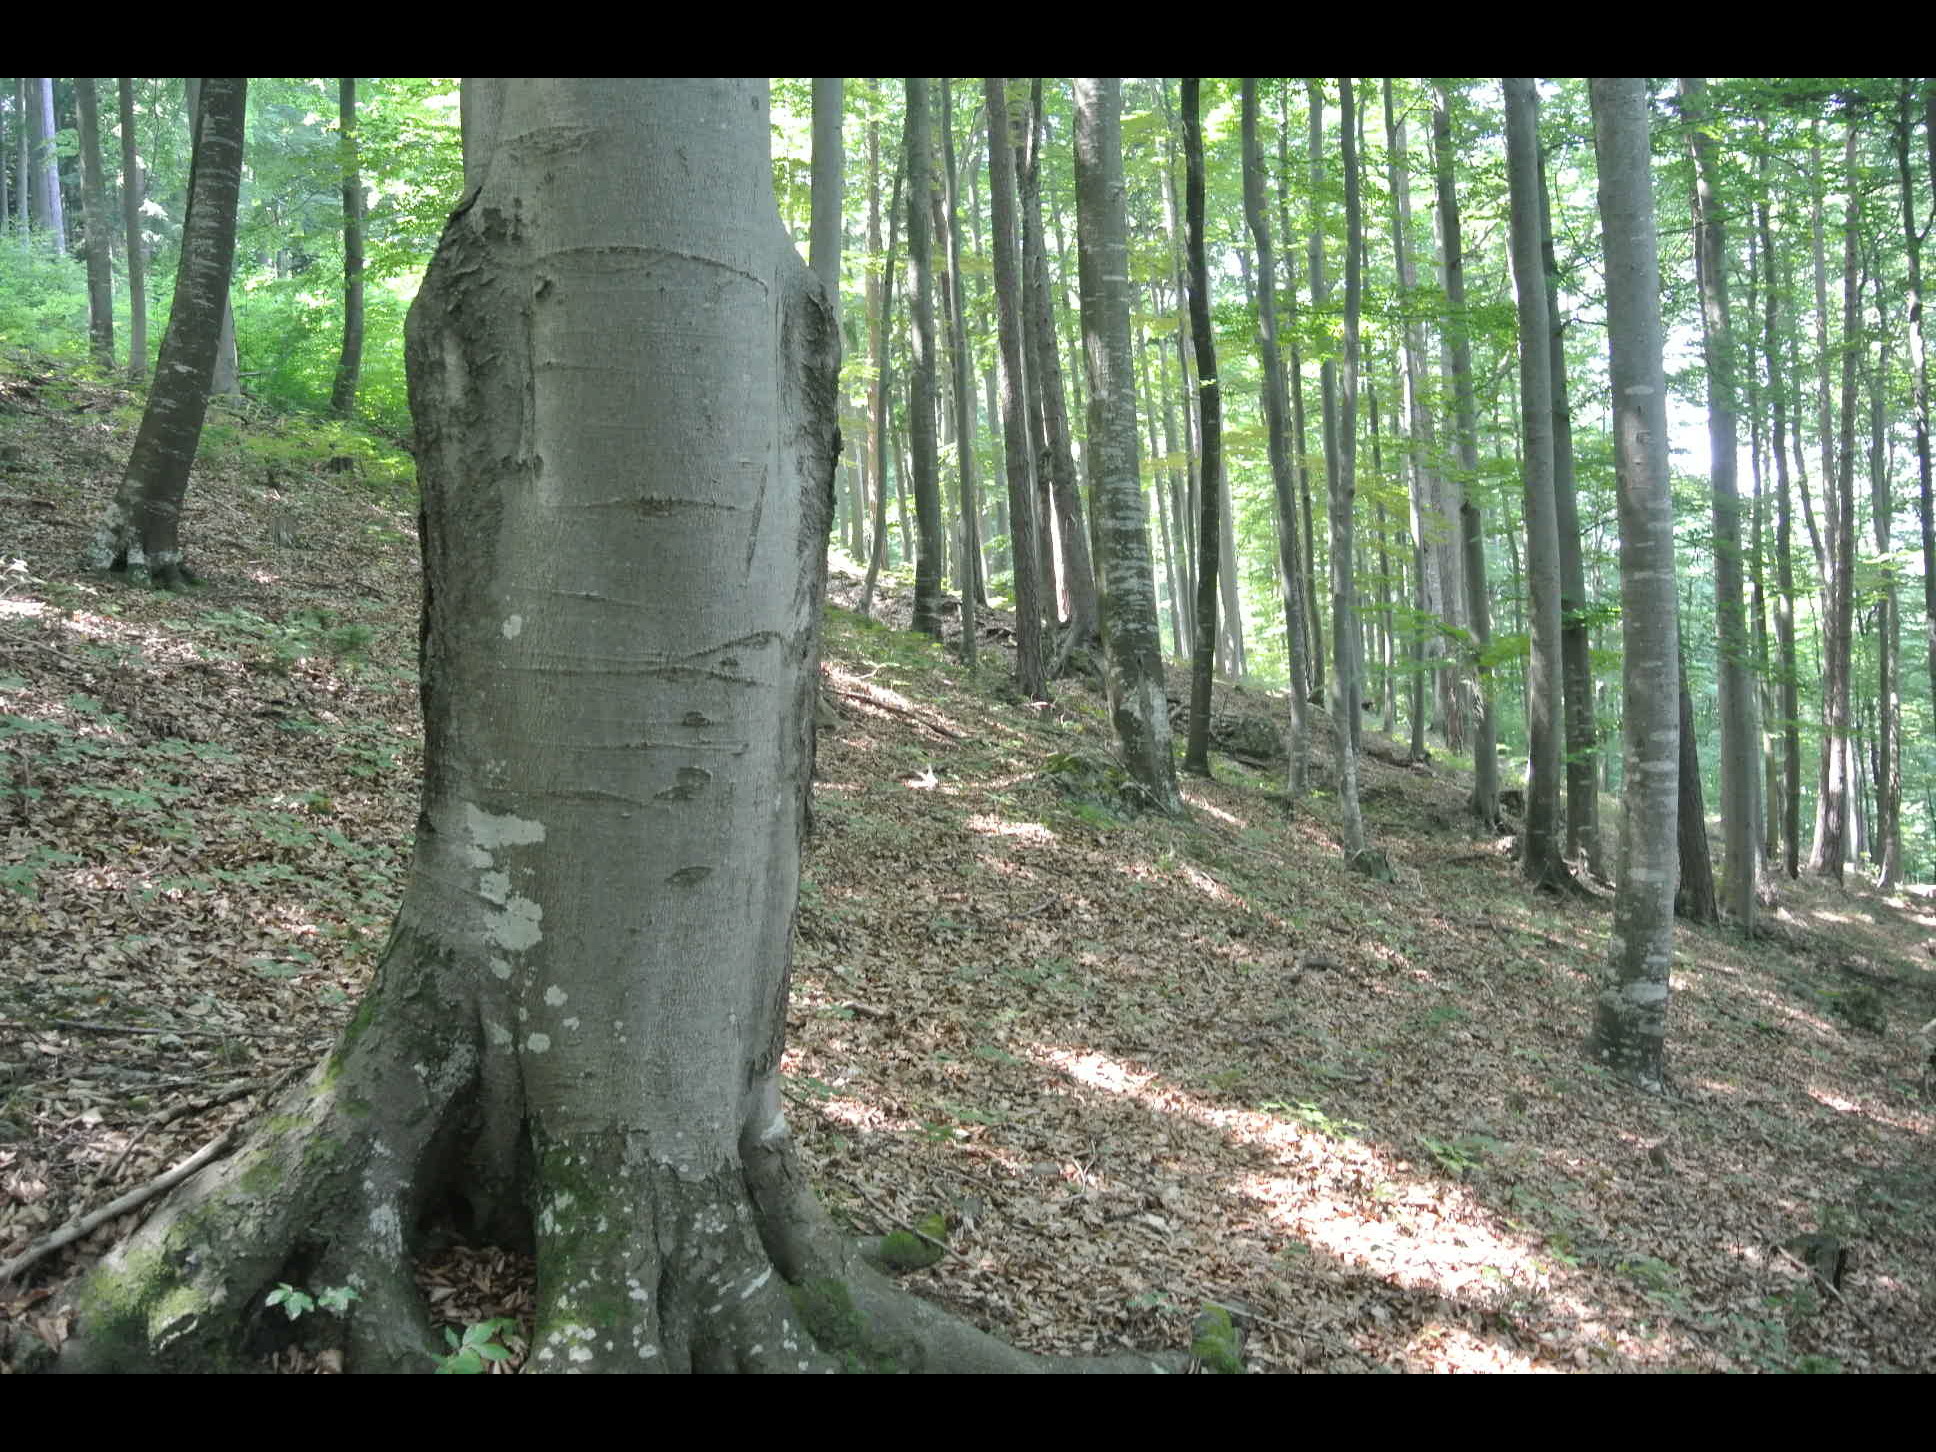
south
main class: Woodland
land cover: Broadleaved woodland
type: beech forest
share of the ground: > 75 %
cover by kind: broadleaved forest trees 80 %, coniferous forest trees 20 %
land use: Forestry
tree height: > 5 m
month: July
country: AT
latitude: 47.6553
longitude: 16.1409
